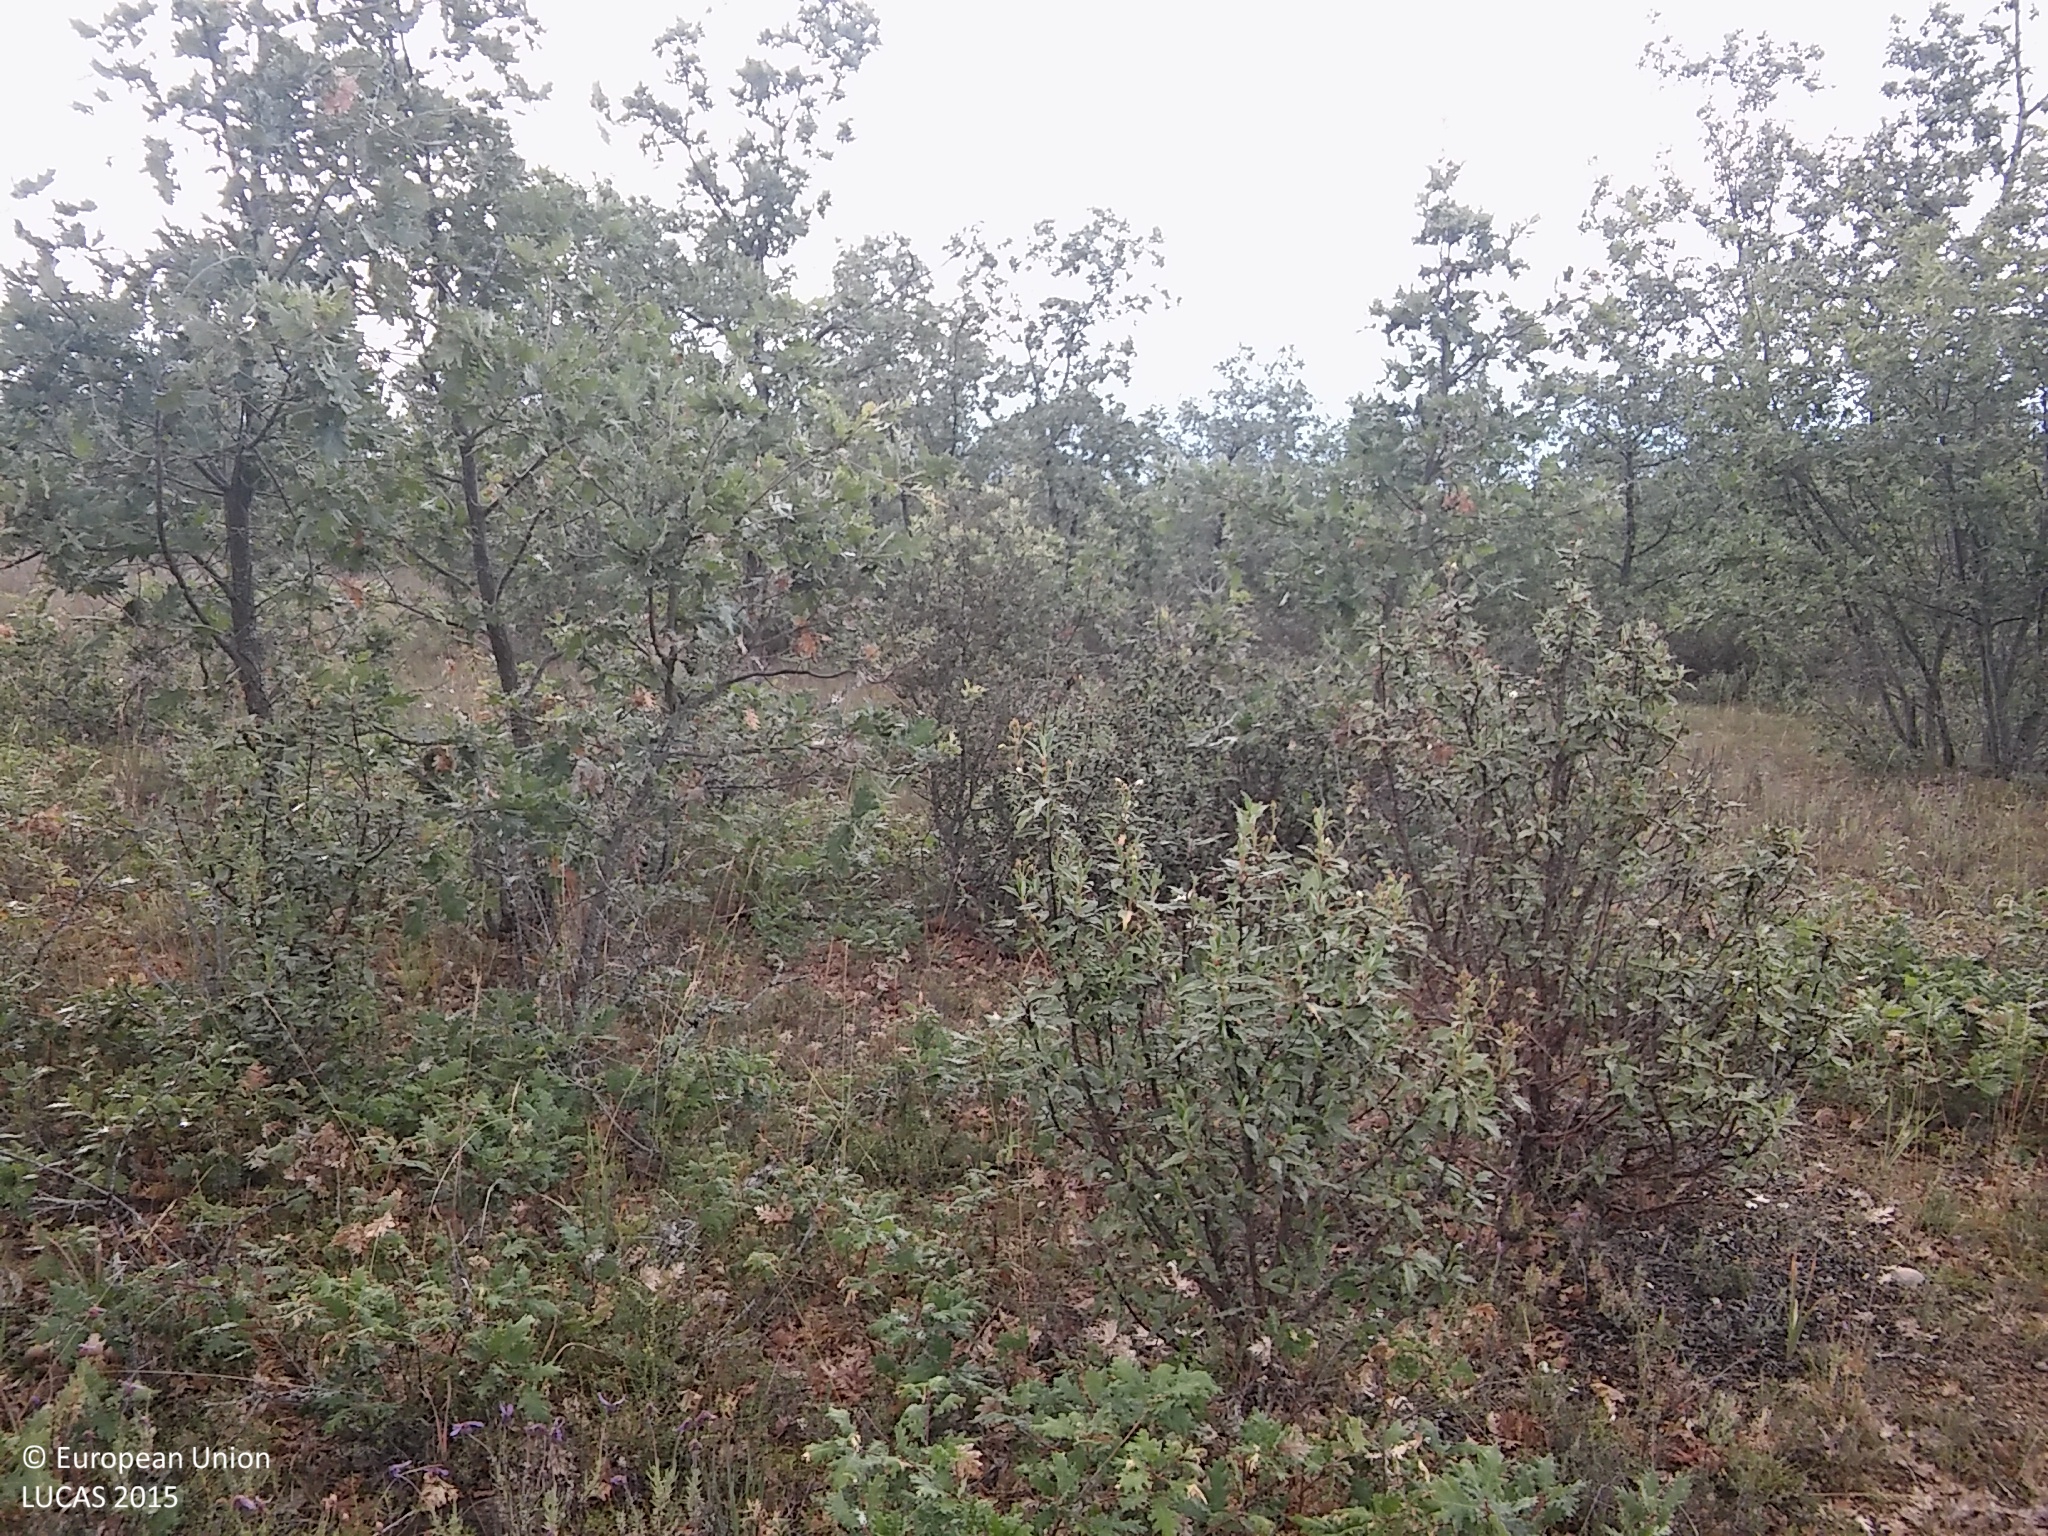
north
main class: Woodland
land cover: Broadleaved woodland
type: acidophilous oak and oak-birch forest
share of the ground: 10 - 25 %
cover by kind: shrubs 50 %, broadleaved forest trees 20 %, lichens and mosses 20 %, herbaceous plants 10 %
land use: Forestry
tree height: > 5 m
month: June
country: ES
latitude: 41.4684
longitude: -3.7856
